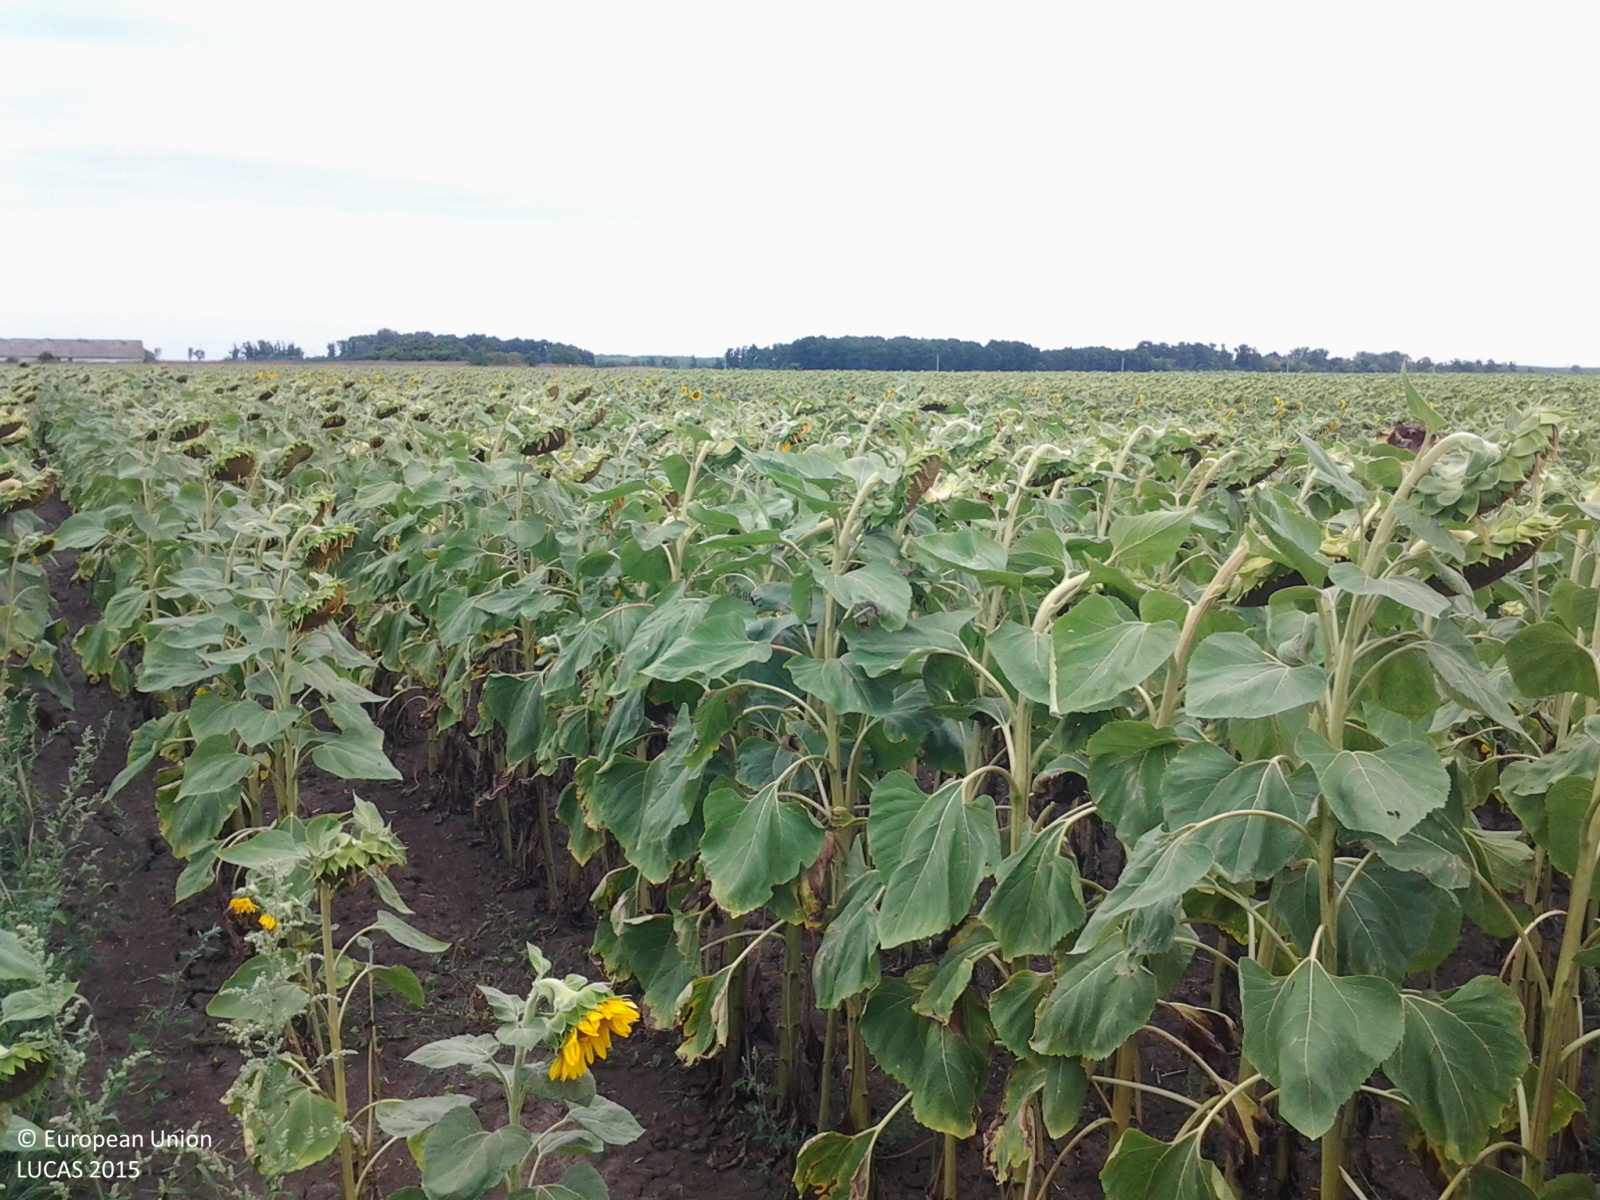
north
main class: Cropland
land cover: Sunflower
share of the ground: > 75 %
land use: Agriculture (excluding fallow land and kitchen gardens)
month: July
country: HU
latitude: 47.3016
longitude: 20.5182
